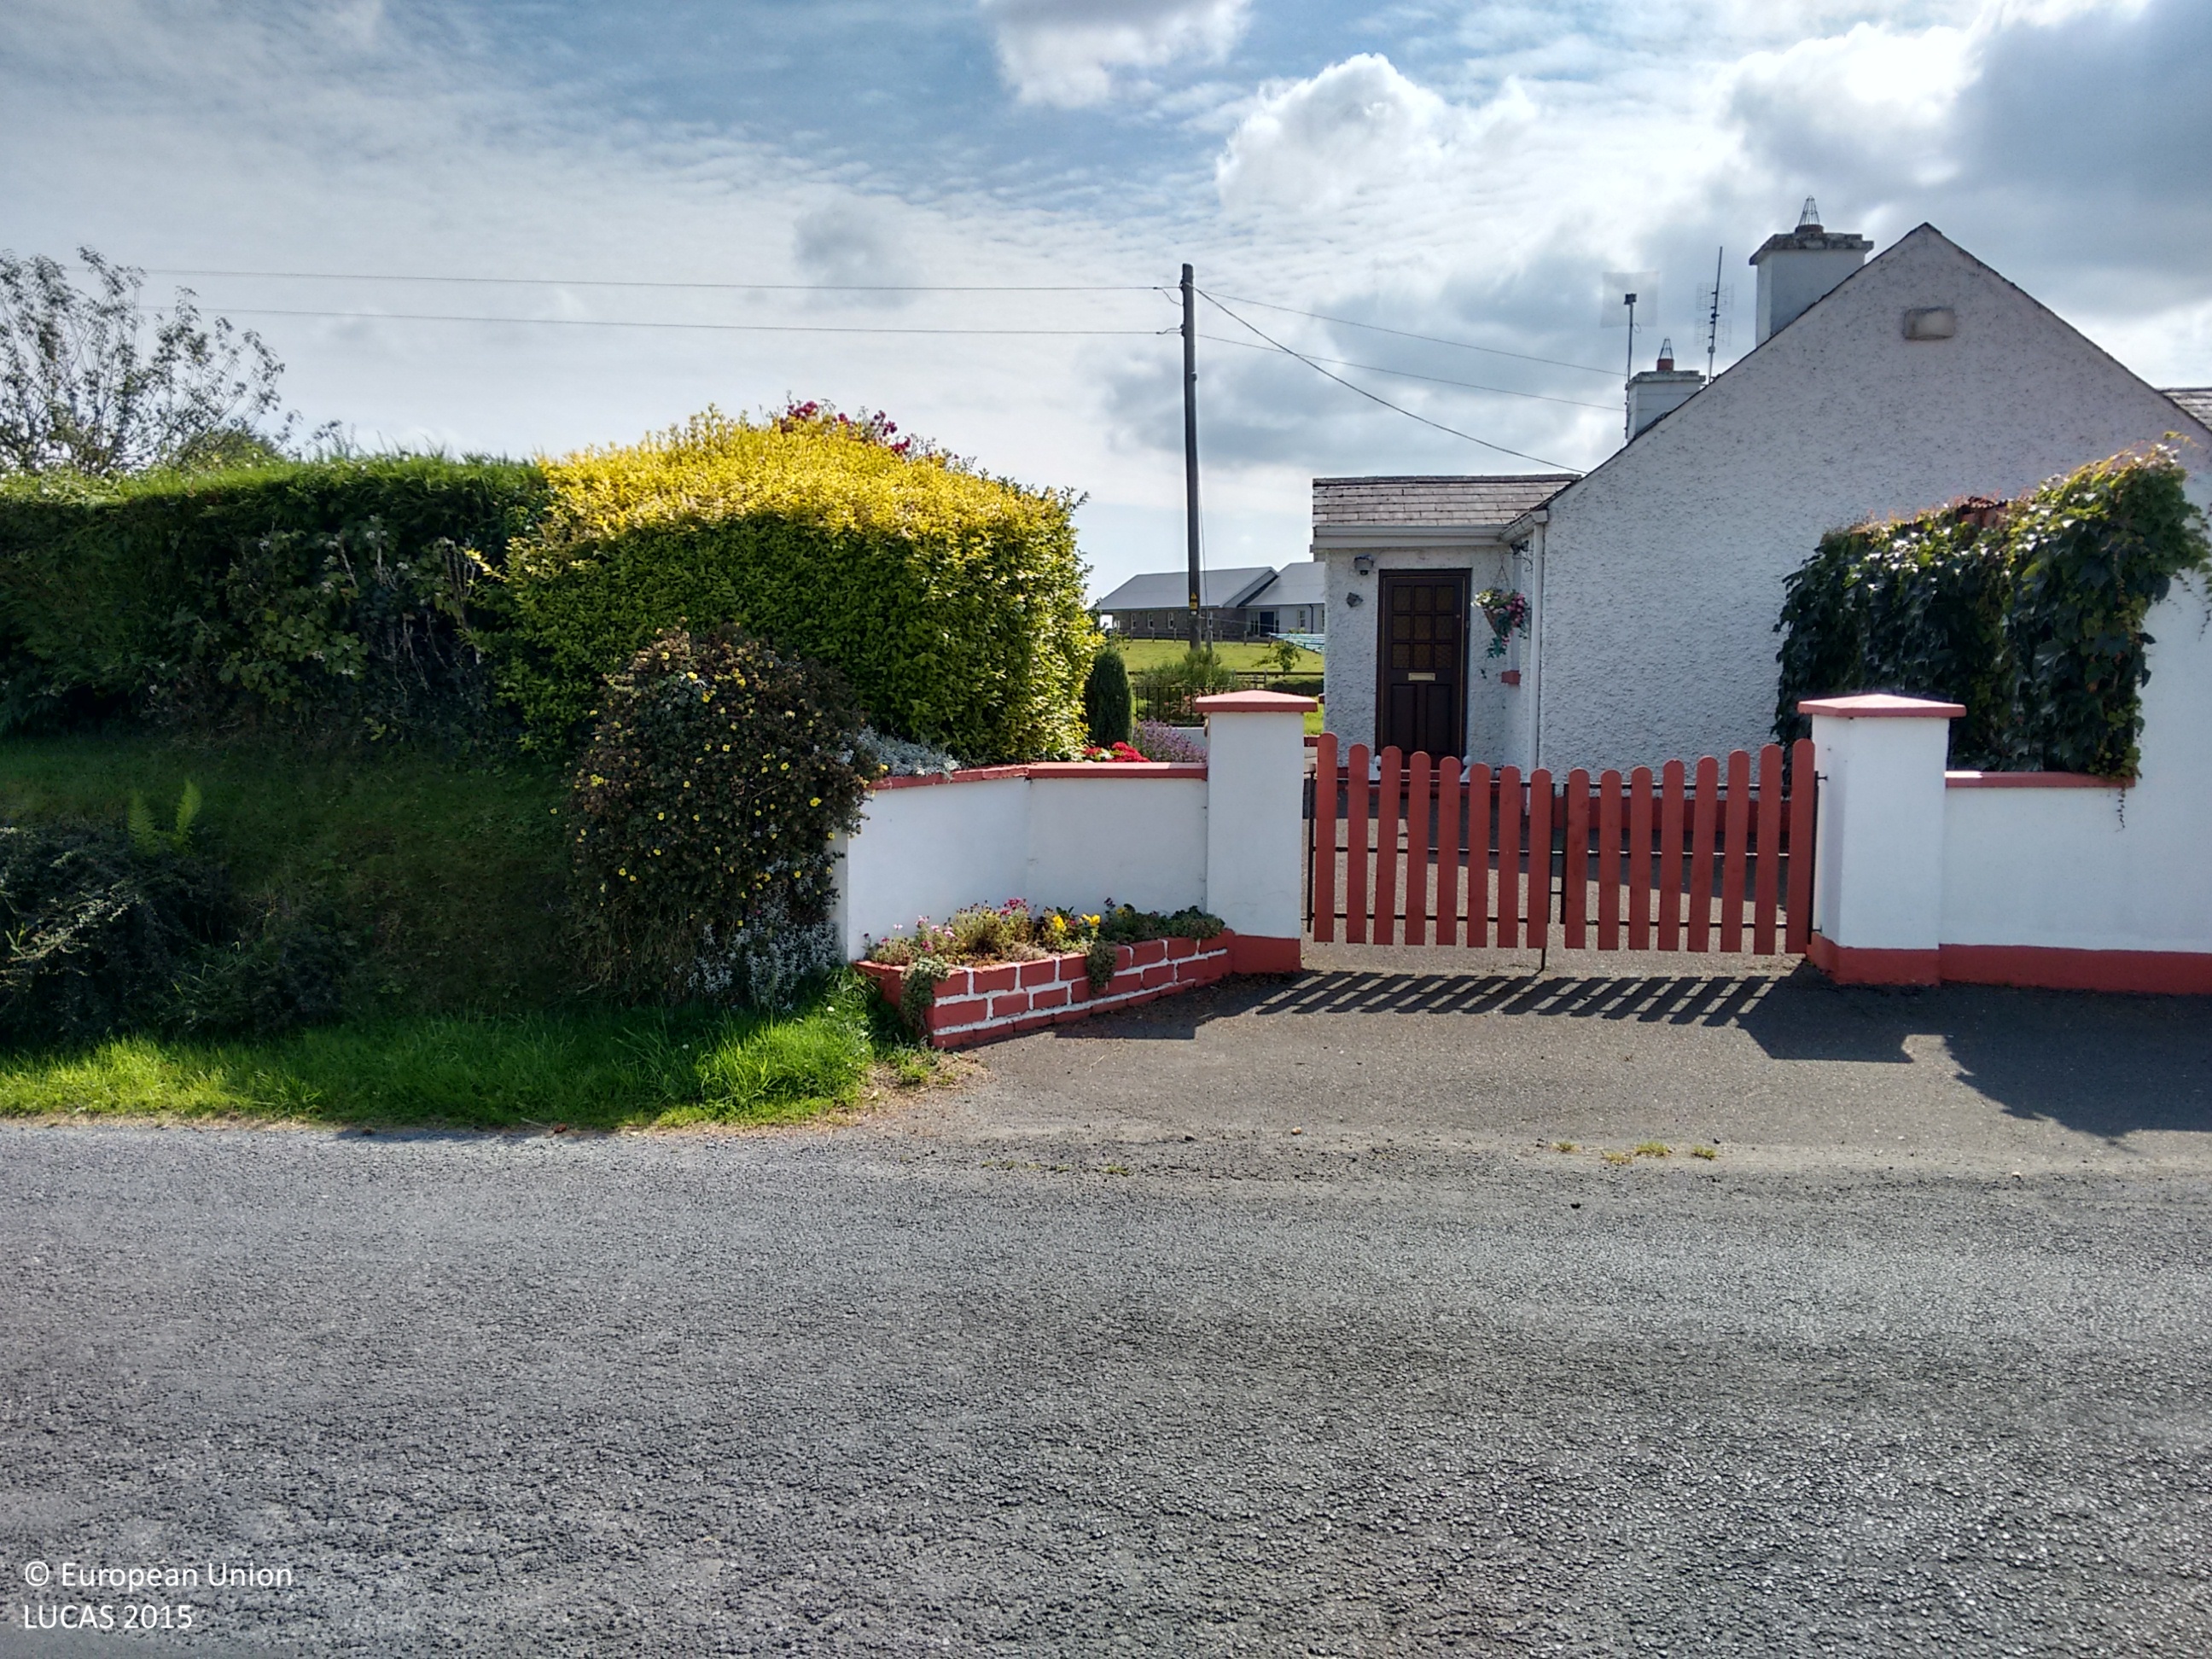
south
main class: Grassland
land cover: Grassland with sparse tree/shrub cover
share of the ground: > 75 %
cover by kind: herbaceous plants 90 %, broadleaved forest trees 5 %, shrubs 5 %
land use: Residential
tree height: < 5 m
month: August
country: IE
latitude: 52.9990
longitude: -7.4872
